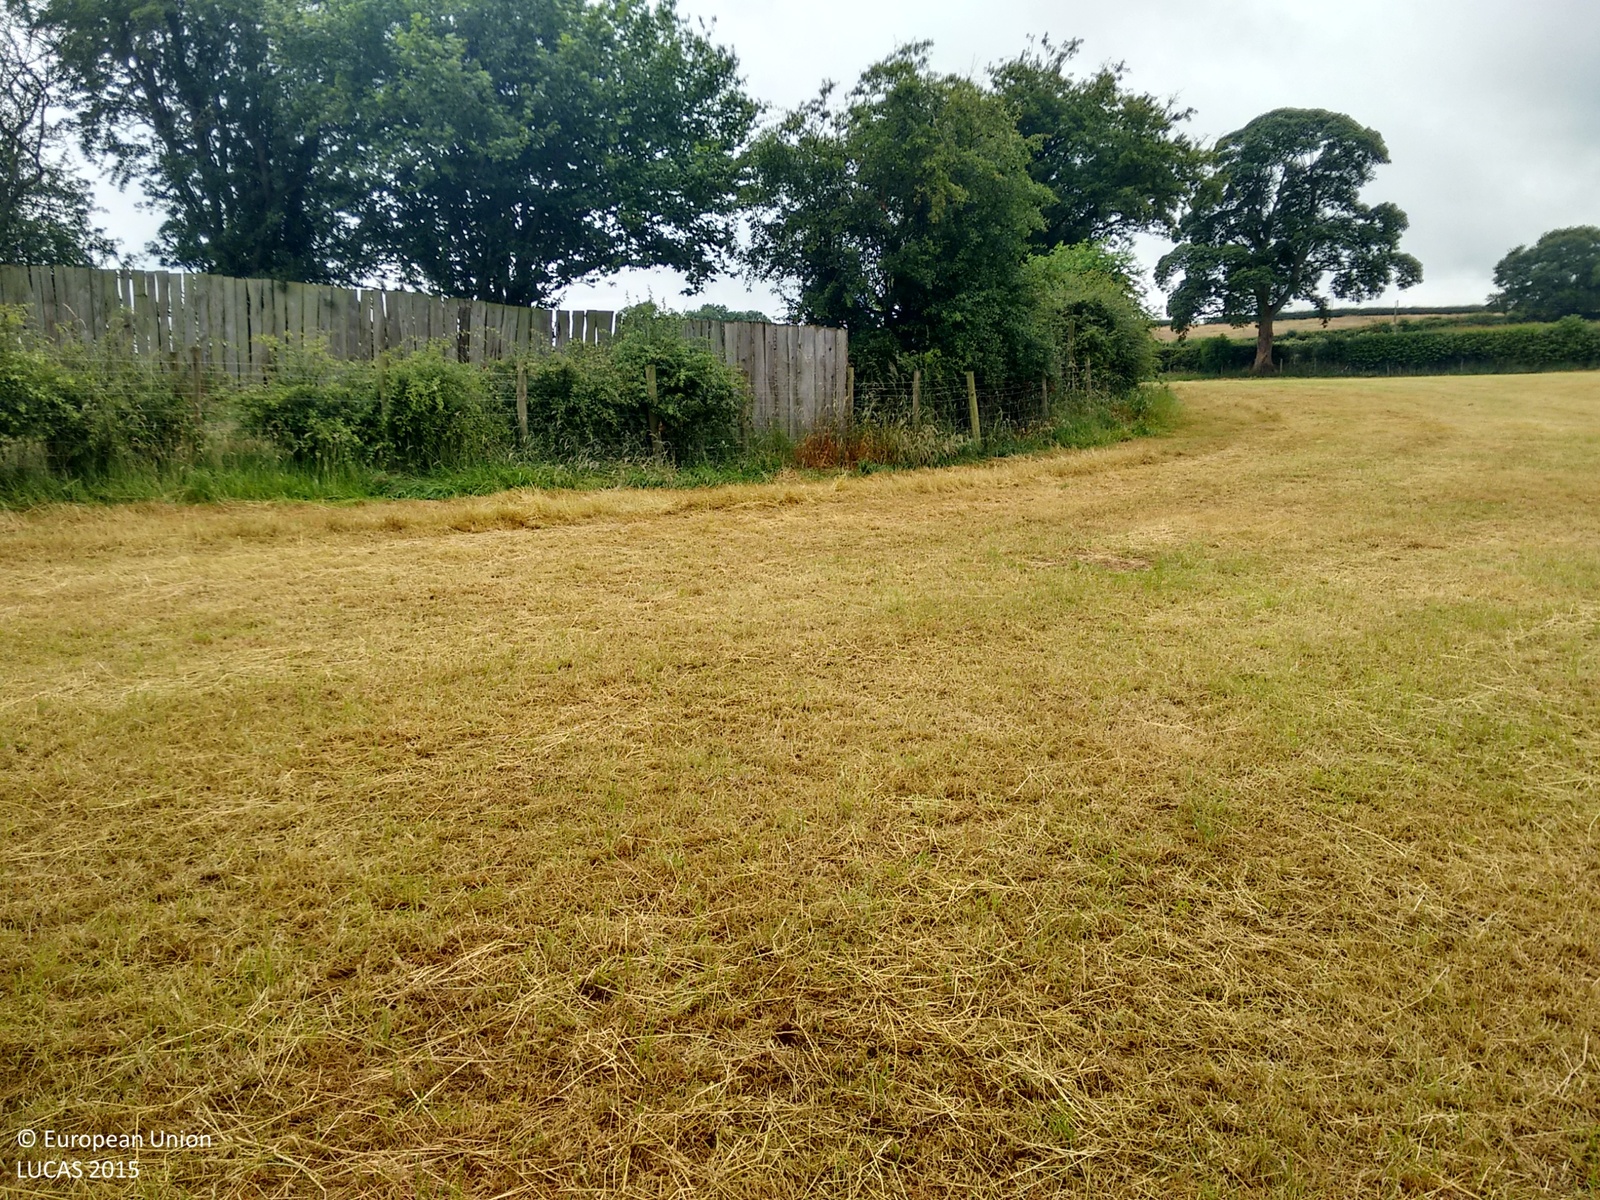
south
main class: Grassland
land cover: Grassland without tree/shrub cover
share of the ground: > 75 %
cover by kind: herbaceous plants 100 %
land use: Agriculture (excluding fallow land and kitchen gardens)
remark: Harvested field
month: July
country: GB
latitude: 52.9288
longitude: -2.3664
